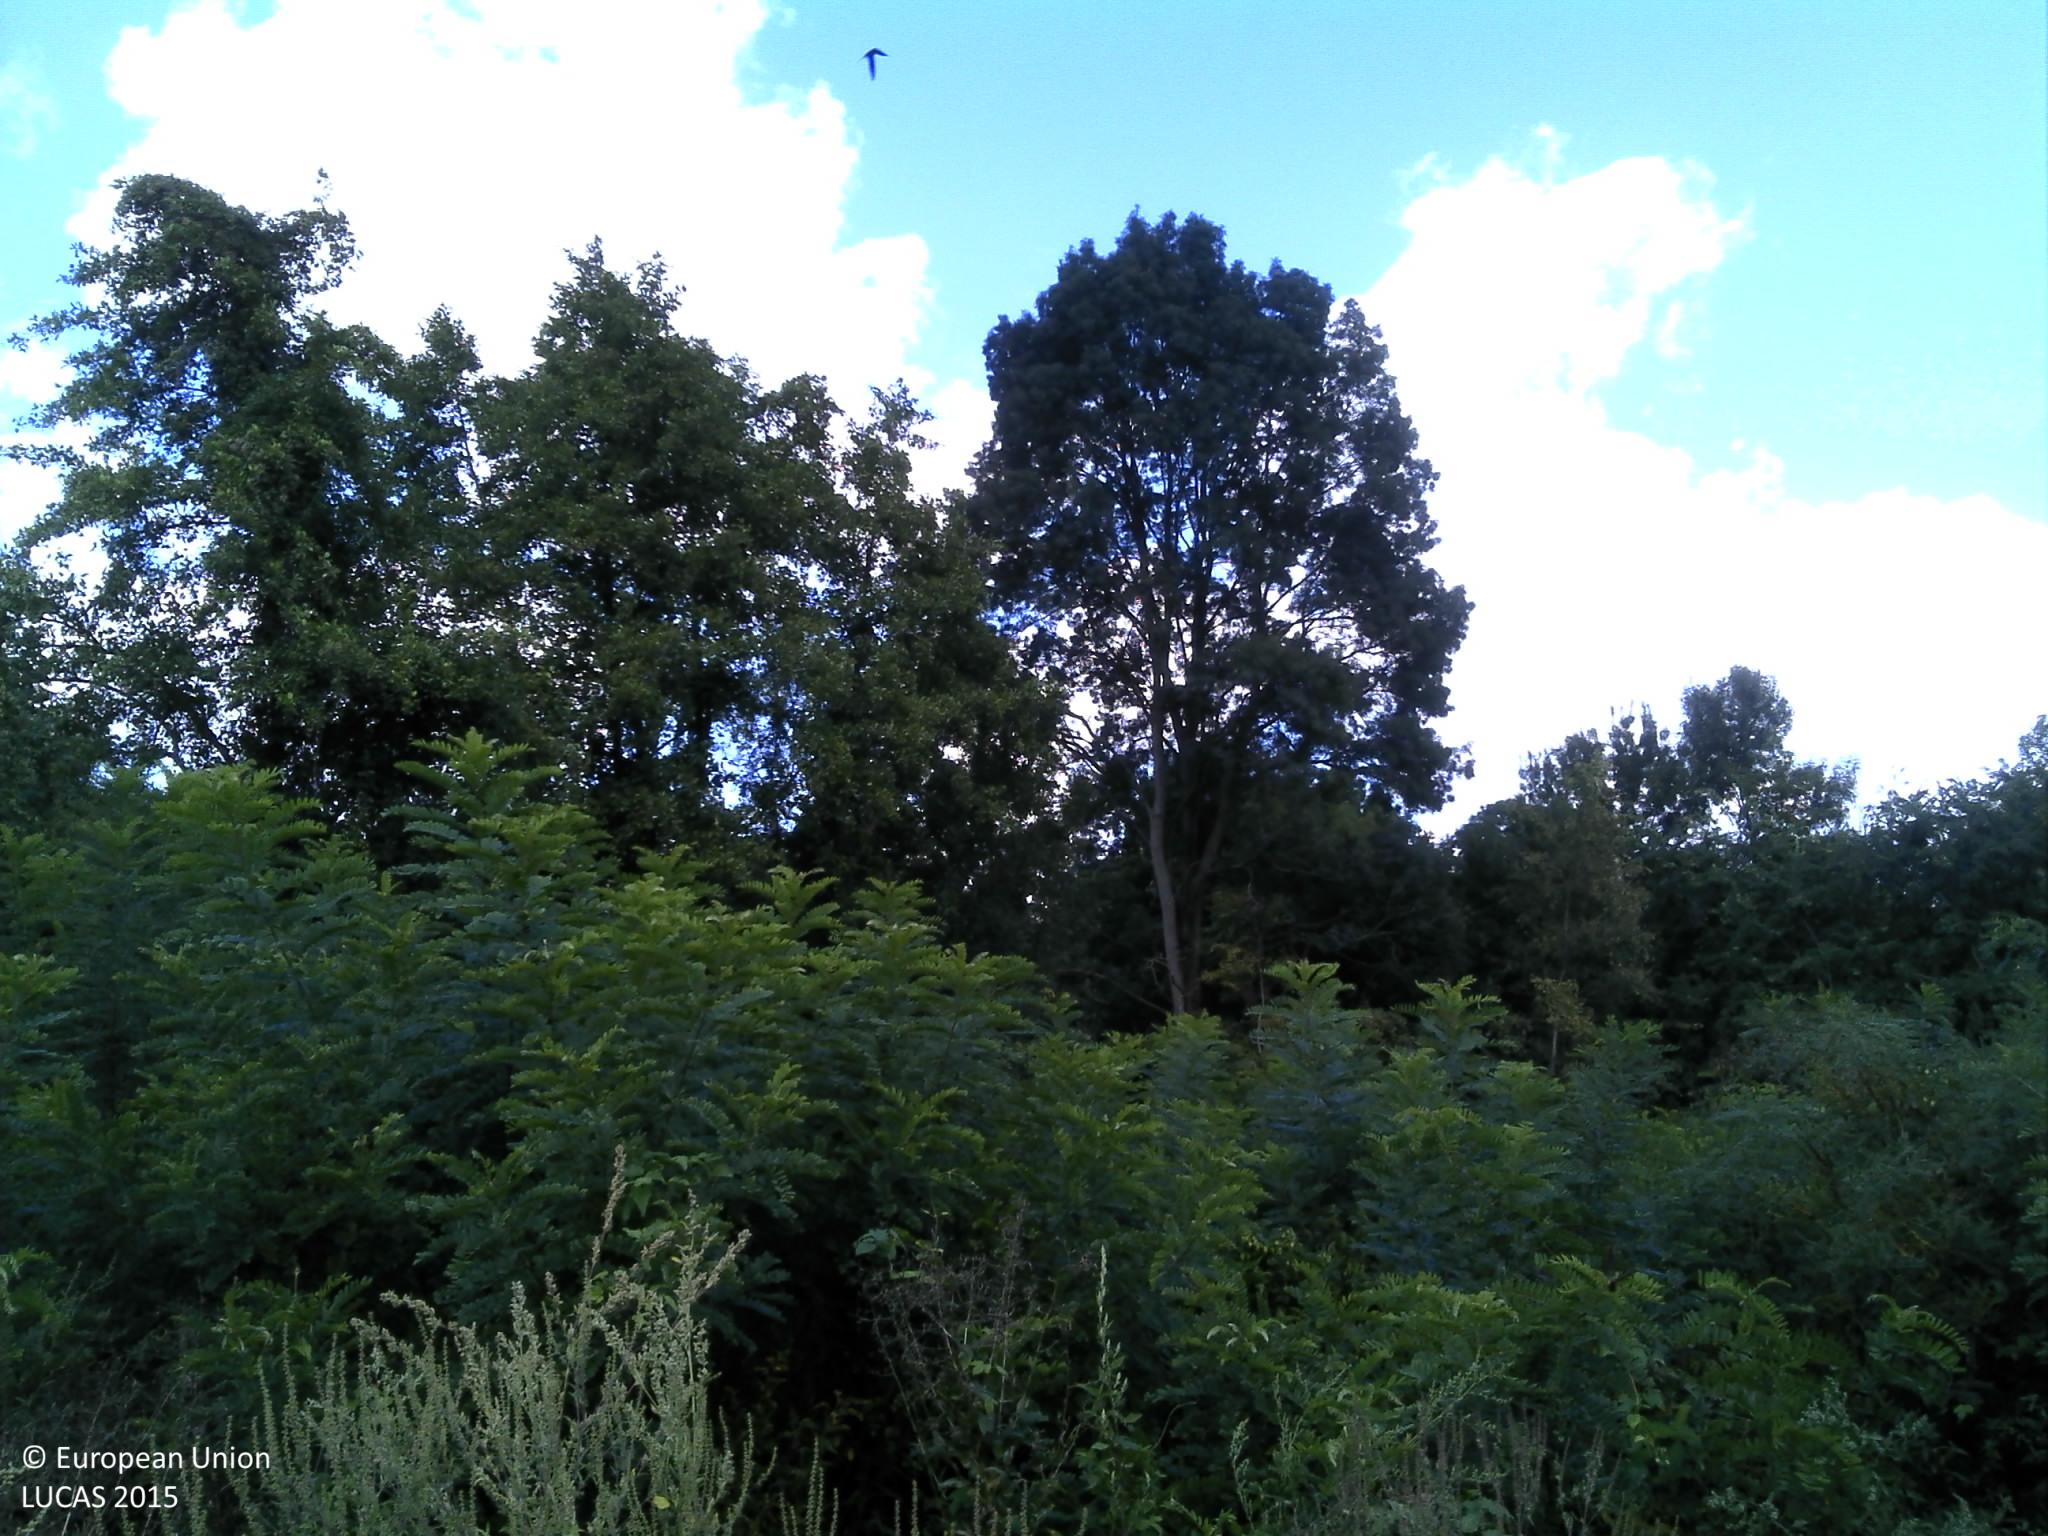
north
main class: Woodland
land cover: Broadleaved woodland
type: acidophilous oak and oak-birch forest
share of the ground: > 75 %
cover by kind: broadleaved forest trees 100 %
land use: Forestry
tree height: > 5 m
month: September
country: HR
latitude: 45.7165
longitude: 18.5767
